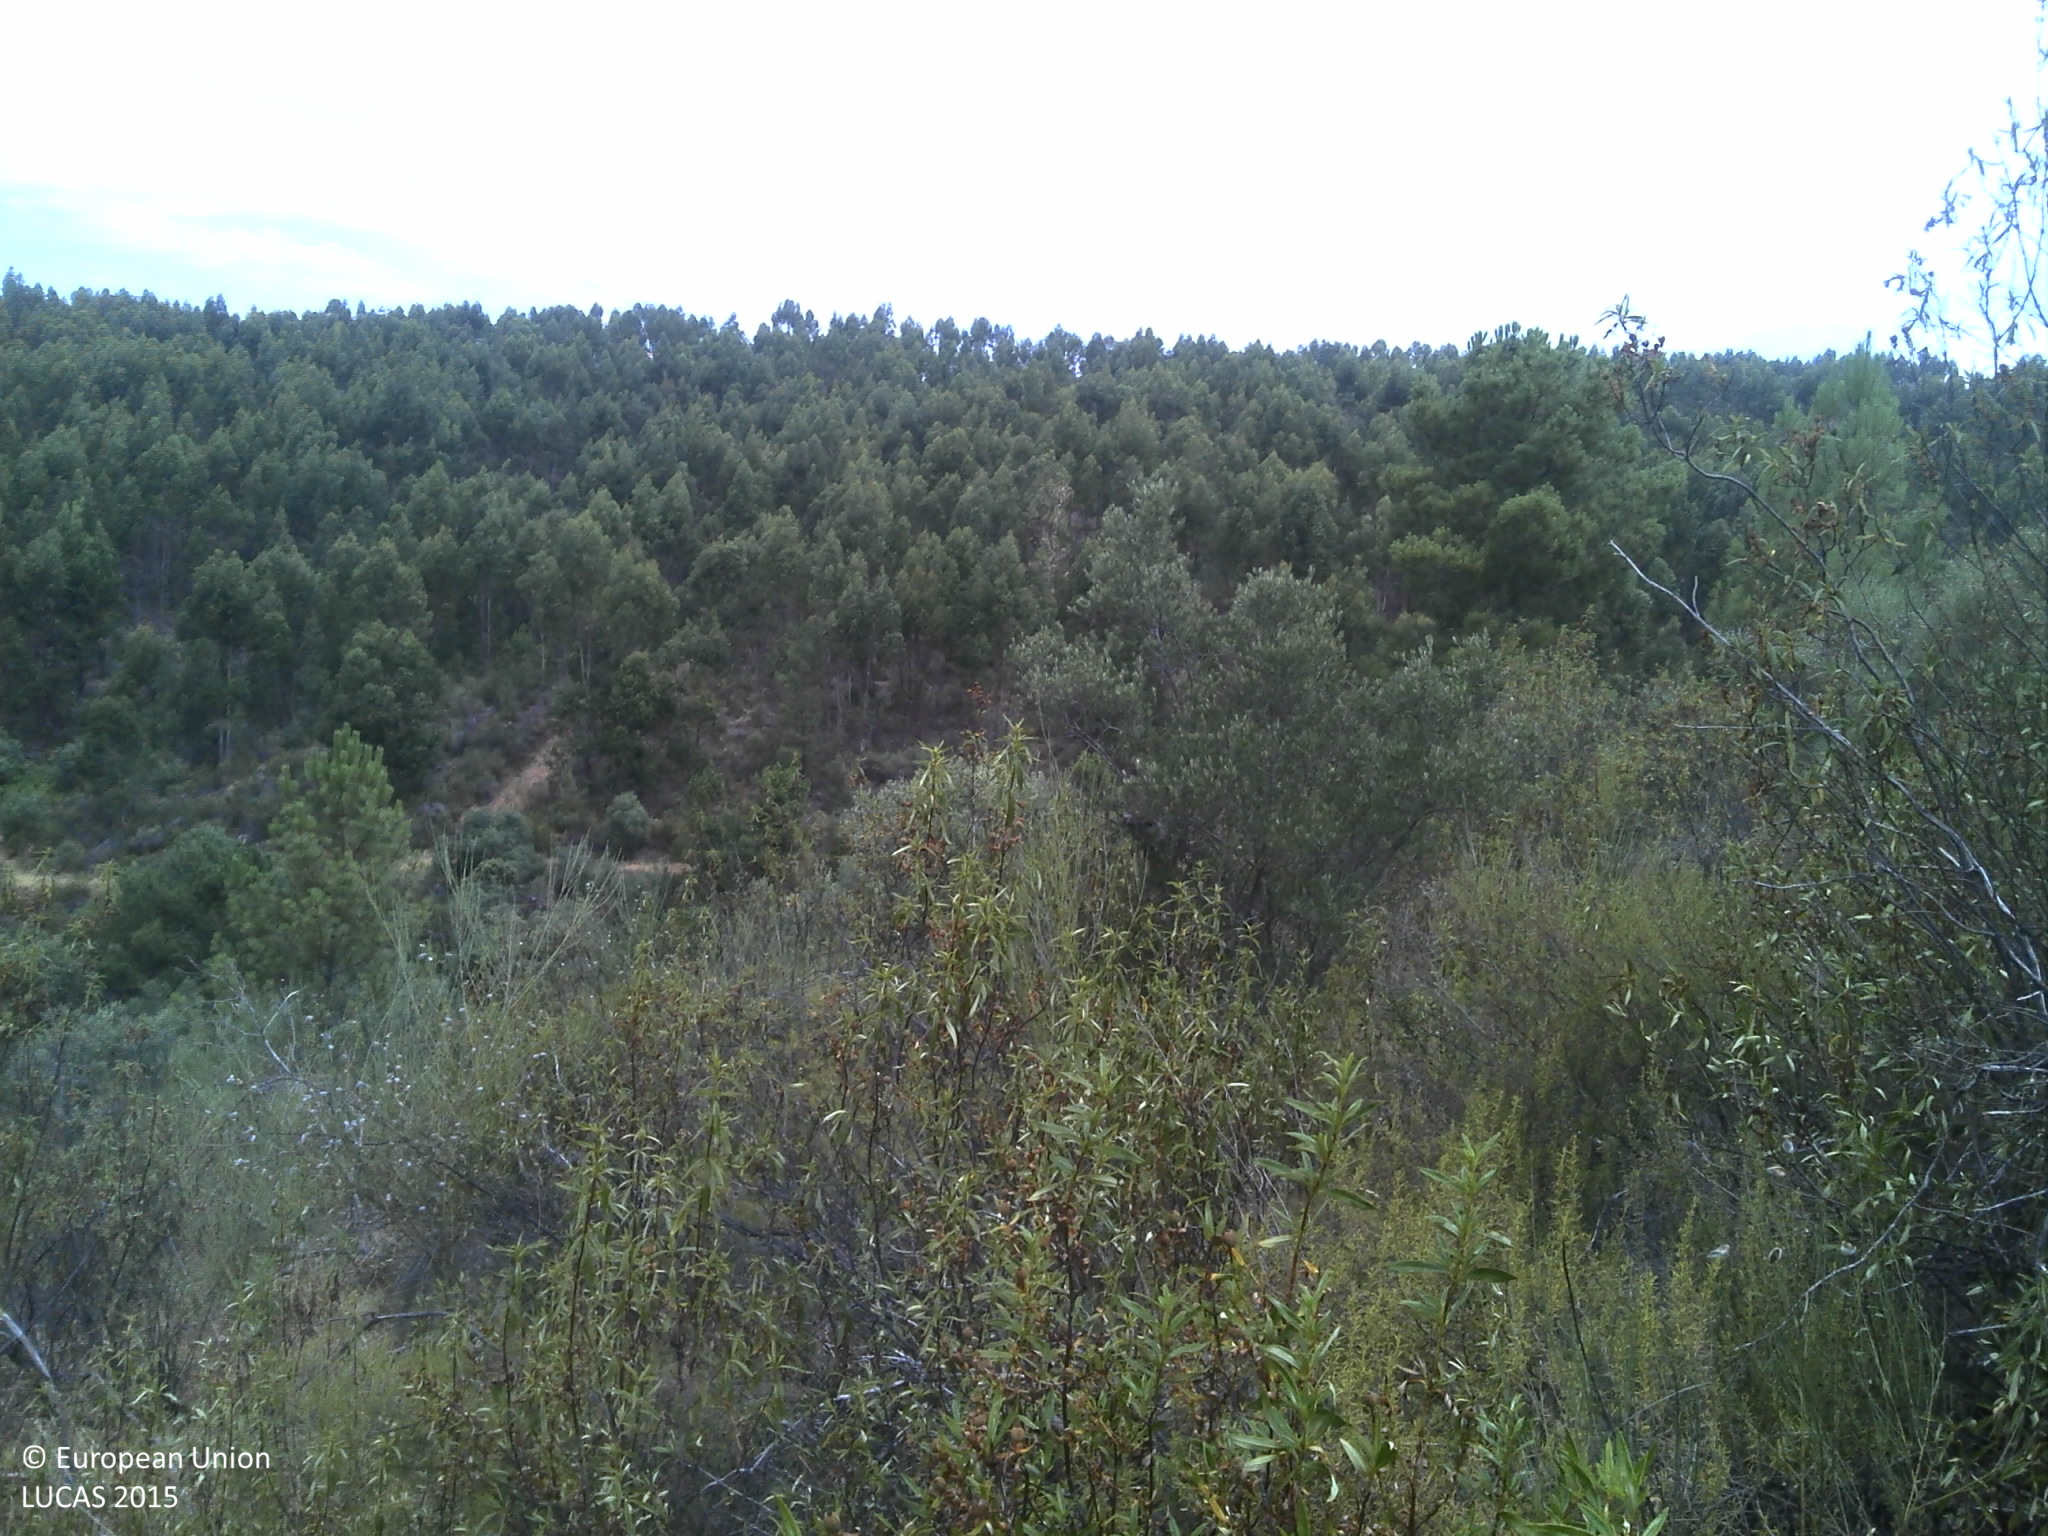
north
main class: Woodland
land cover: Pine dominated coniferous woodland
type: coniferous forest of the mediterranean region
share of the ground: 25 - 50 %
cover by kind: coniferous forest trees 45 %, shrubs 40 %, herbaceous plants 5 %, unconsolidated bare surface 5 %
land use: Forestry
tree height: > 5 m
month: July
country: PT
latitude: 39.8465
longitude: -7.3820
